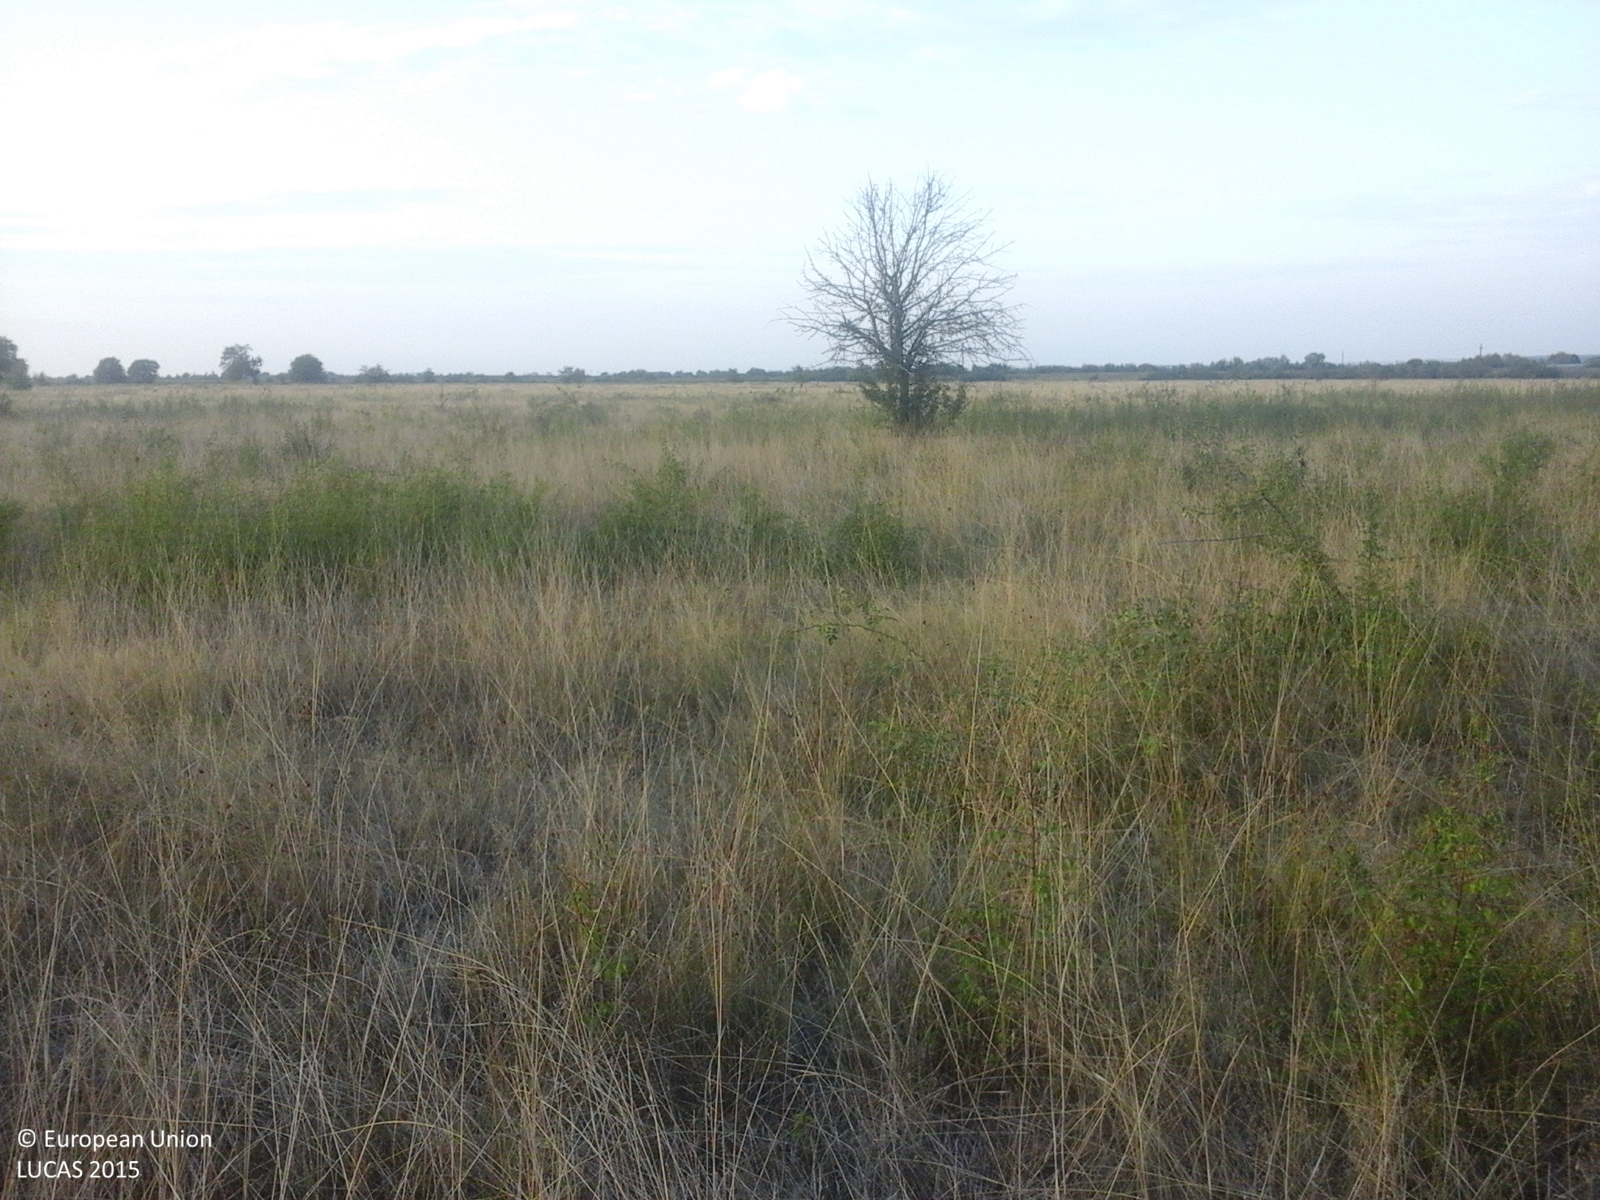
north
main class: Grassland
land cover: Grassland with sparse tree/shrub cover
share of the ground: > 75 %
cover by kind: herbaceous plants 85 %, shrubs 10 %, broadleaved forest trees 5 %
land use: Agriculture (excluding fallow land and kitchen gardens)
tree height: < 5 m
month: August
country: RO
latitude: 46.5193
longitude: 21.9181
